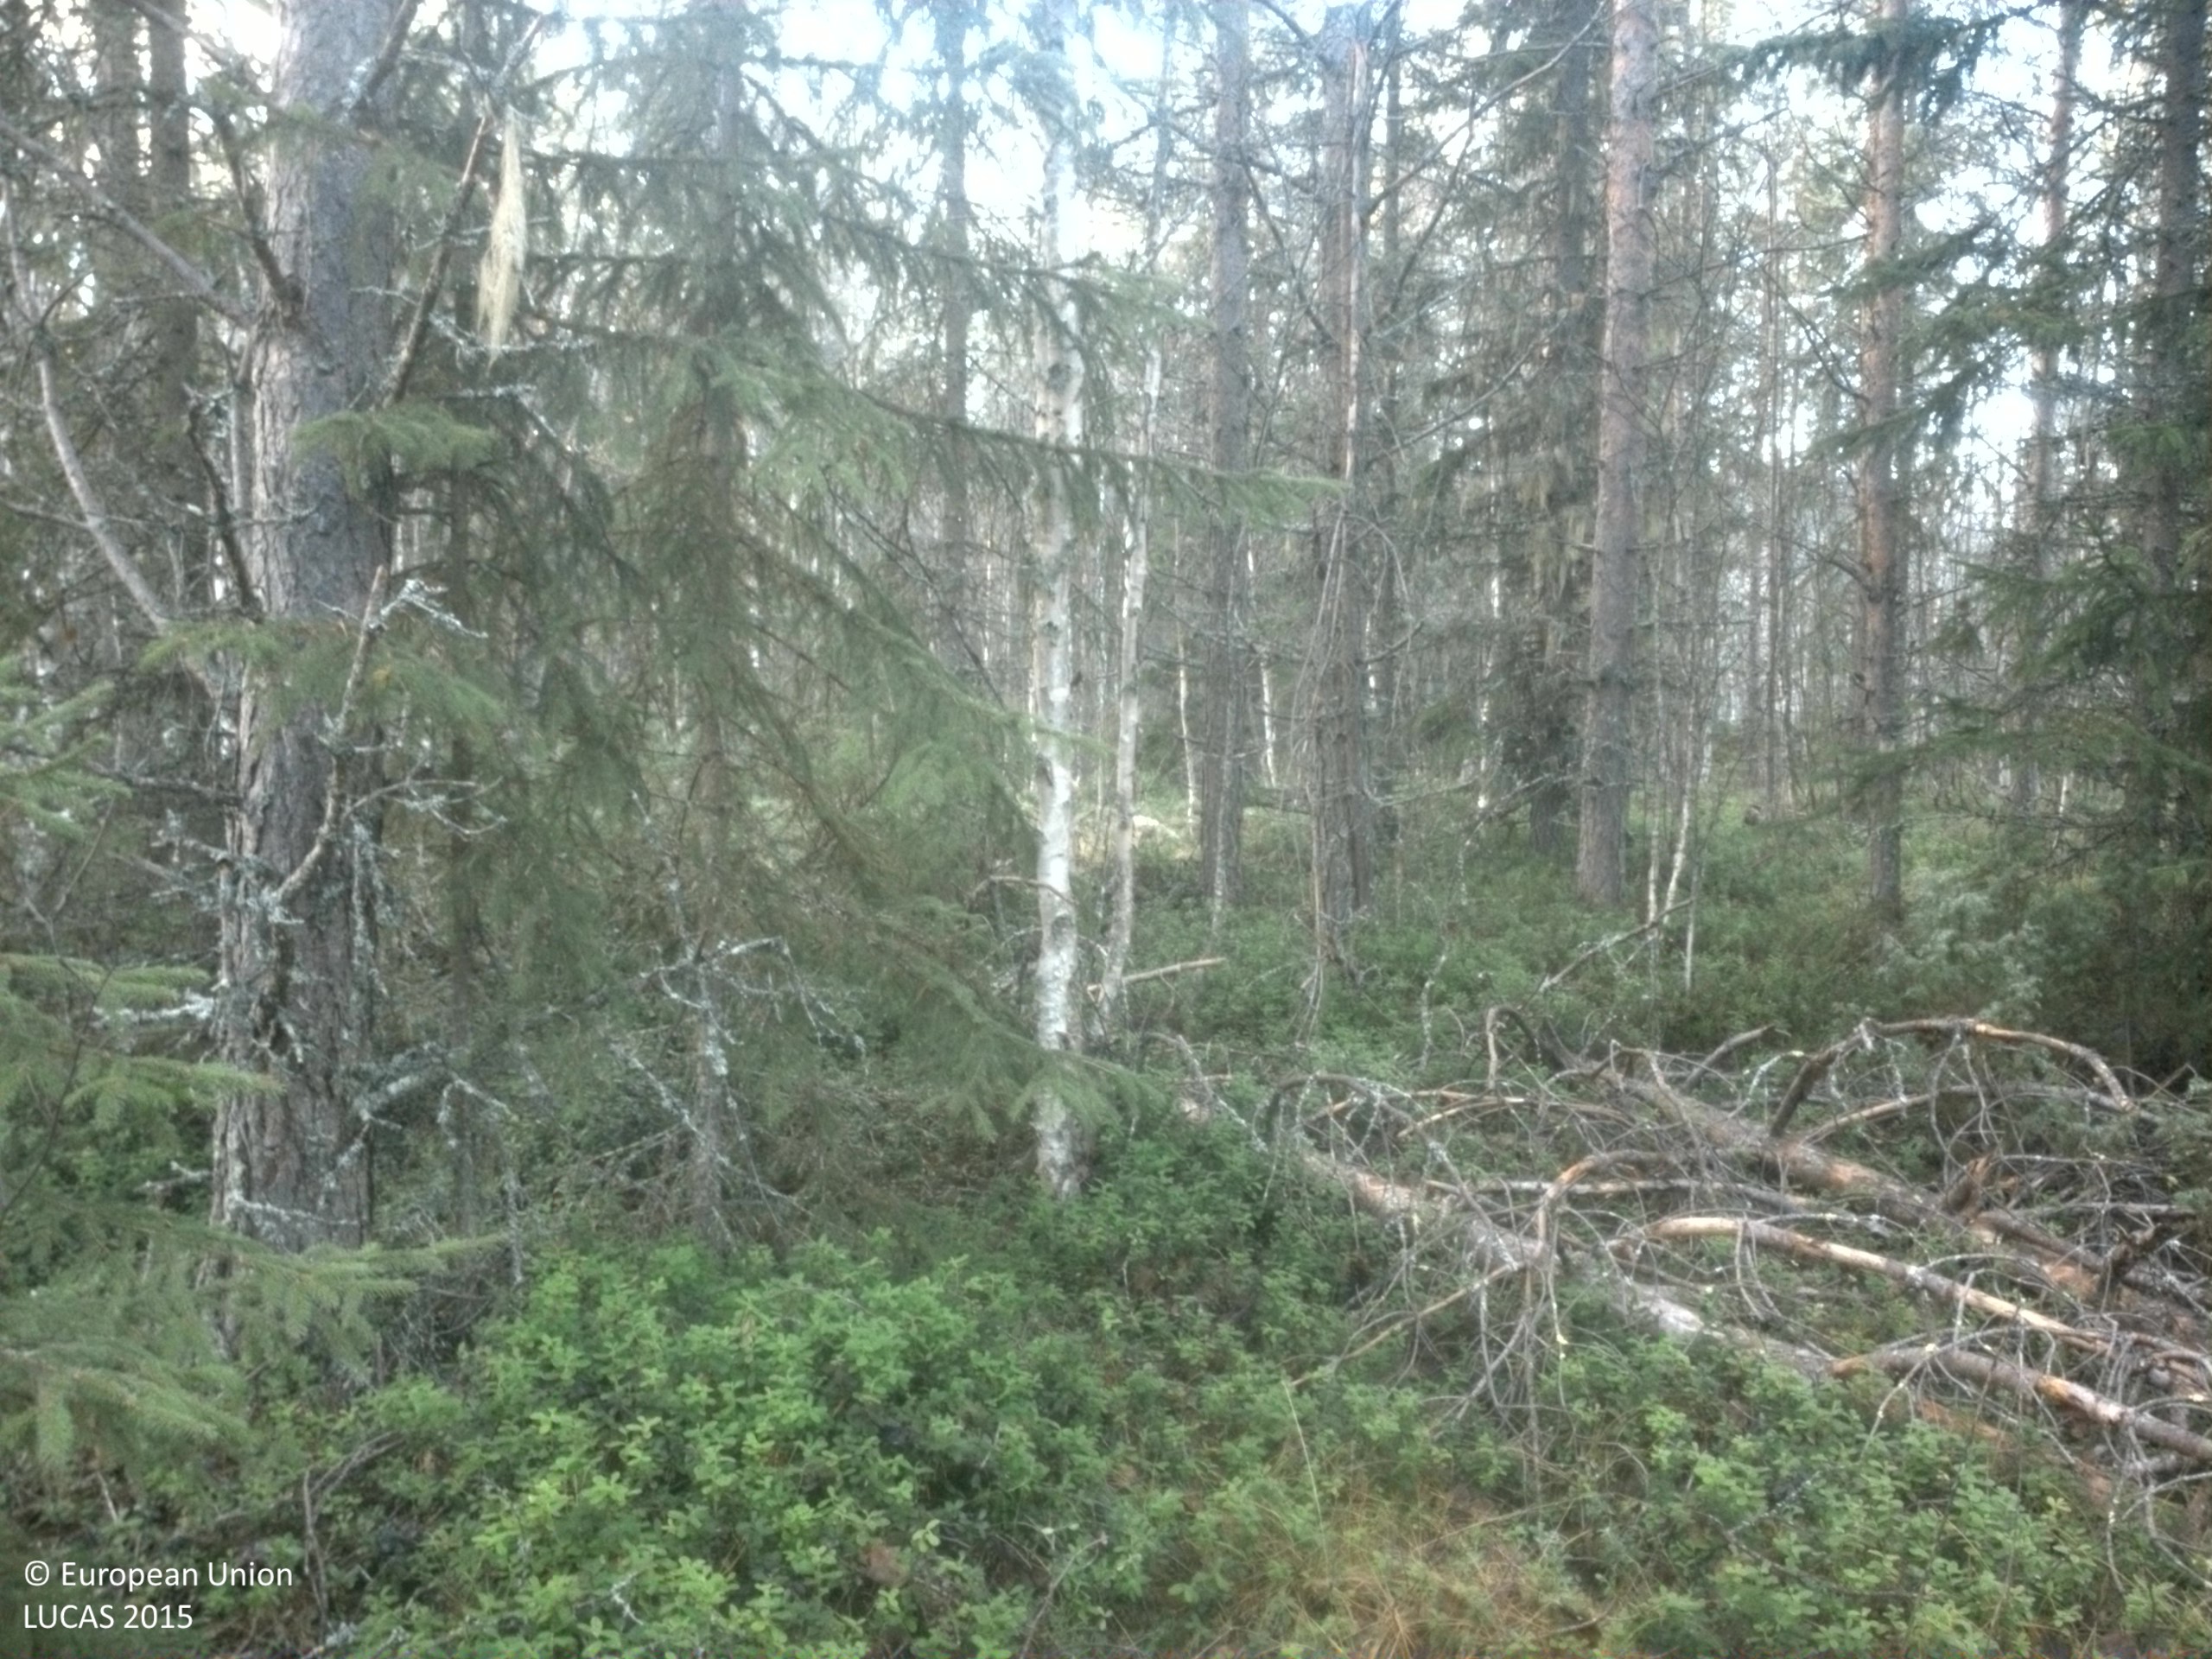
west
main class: Woodland
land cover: Other mixed woodland
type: boreal forest
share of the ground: 50 - 75 %
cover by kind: coniferous forest trees 35 %, shrubs 25 %, broadleaved forest trees 20 %, lichens and mosses 15 %, herbaceous plants 5 %
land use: Forestry
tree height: > 5 m
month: November
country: SE
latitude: 63.8886
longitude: 15.9392
